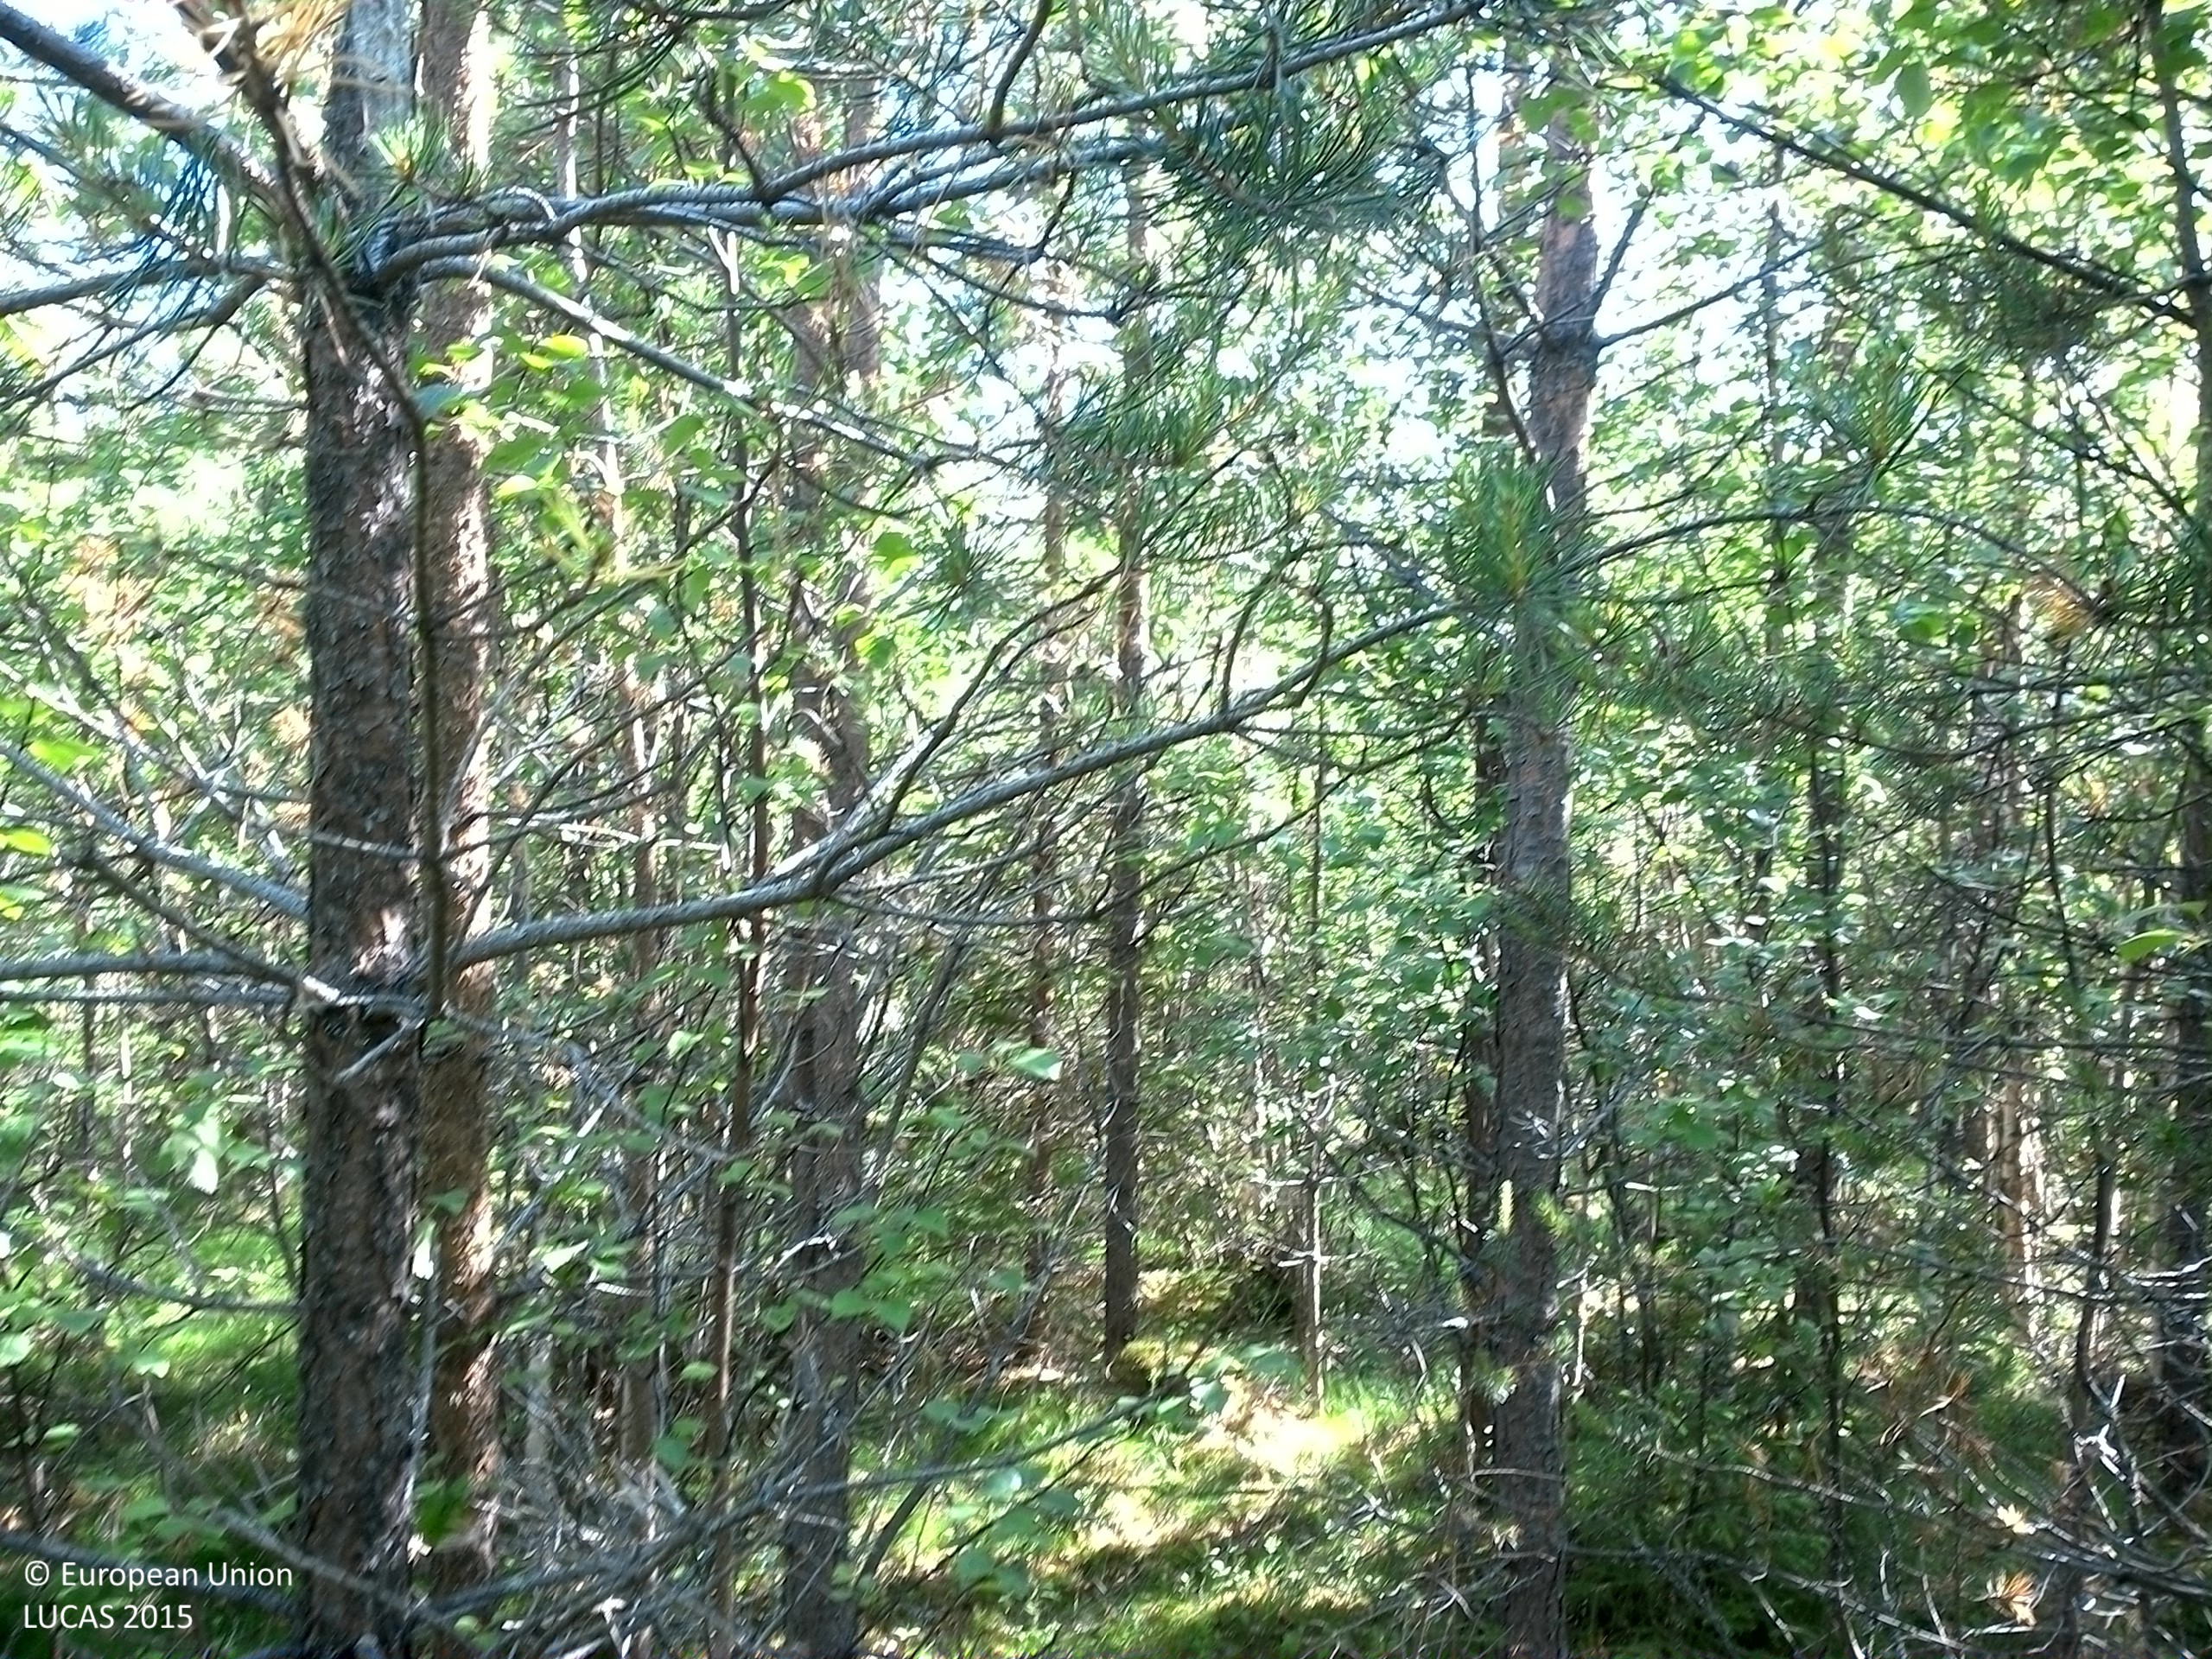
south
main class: Woodland
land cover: Pine dominated mixed woodland
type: boreal forest
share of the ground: > 75 %
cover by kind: coniferous forest trees 45 %, broadleaved forest trees 40 %, lichens and mosses 10 %, herbaceous plants 5 %
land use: Forestry
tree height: < 5 m
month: July
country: SE
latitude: 63.5586
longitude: 17.6832
